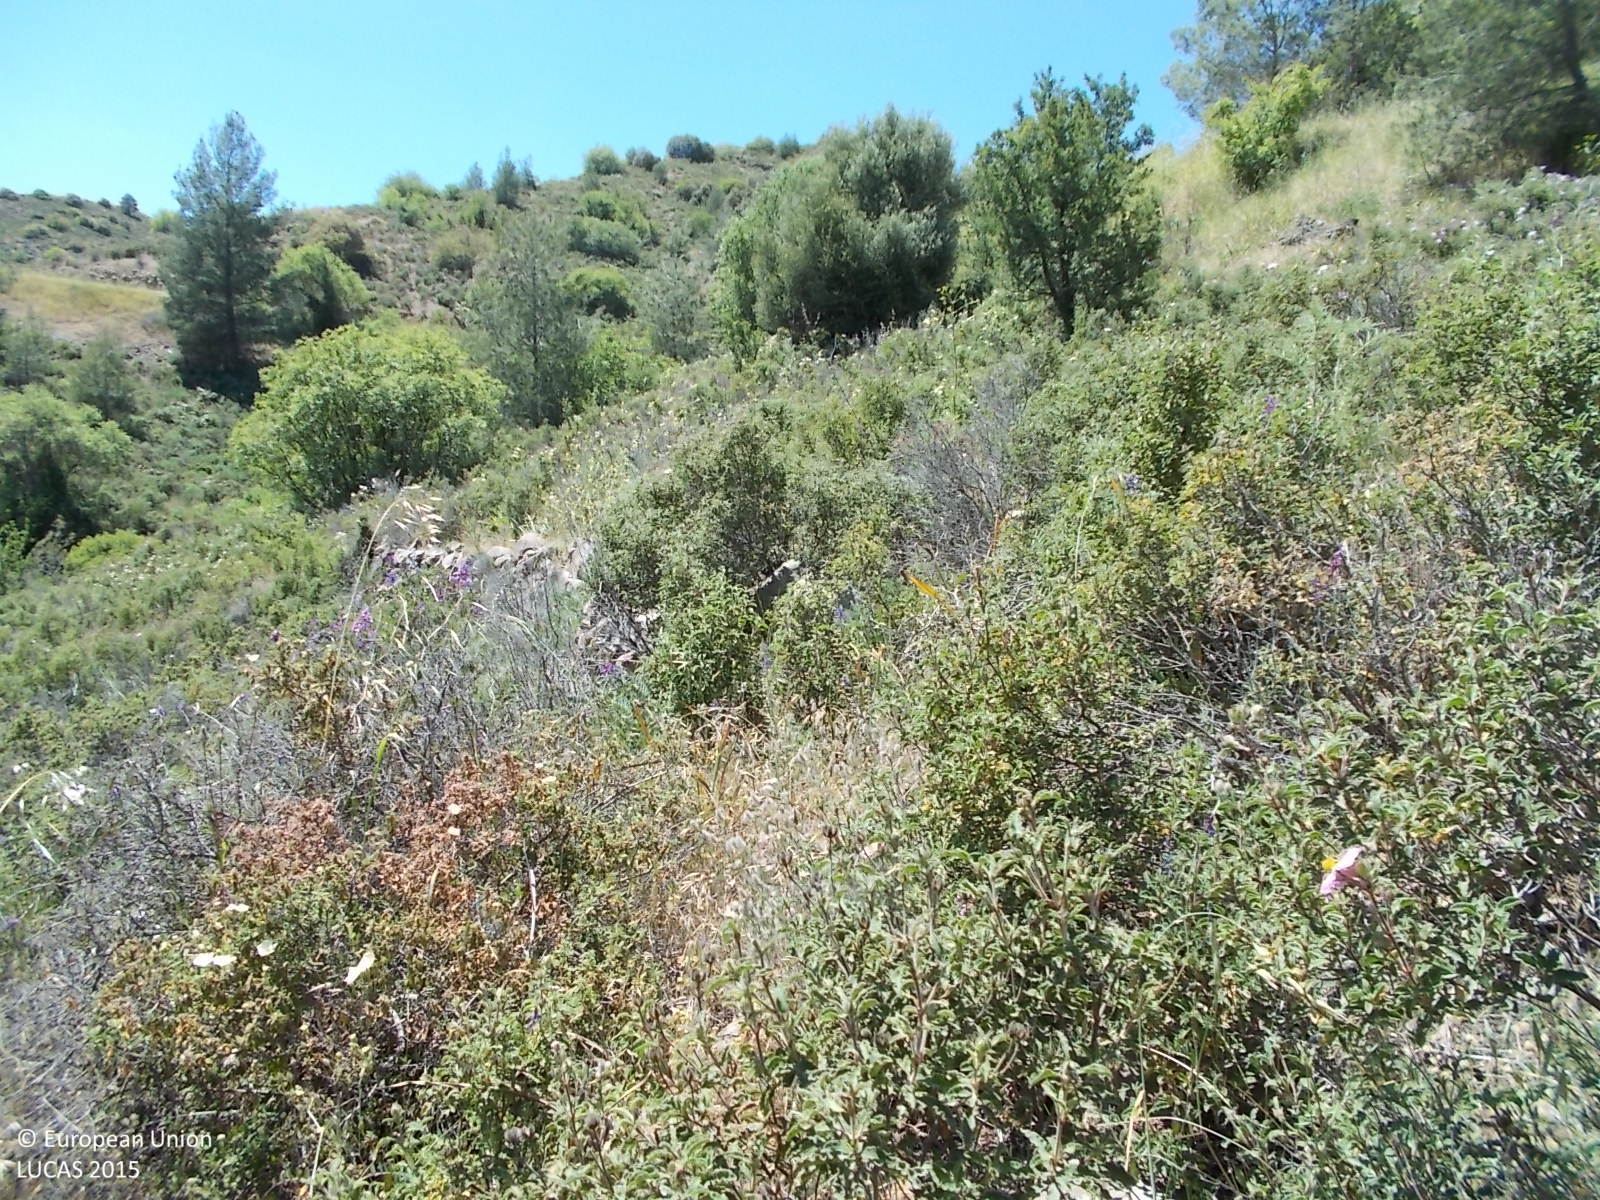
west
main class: Shrubland
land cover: Shrubland with sparse tree cover
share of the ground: > 75 %
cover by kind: shrubs 75 %, unconsolidated bare surface 20 %, coniferous forest trees 5 %
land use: Semi-natural and natural areas not in use
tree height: > 5 m
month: May
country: CY
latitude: 34.9524
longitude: 33.1865
